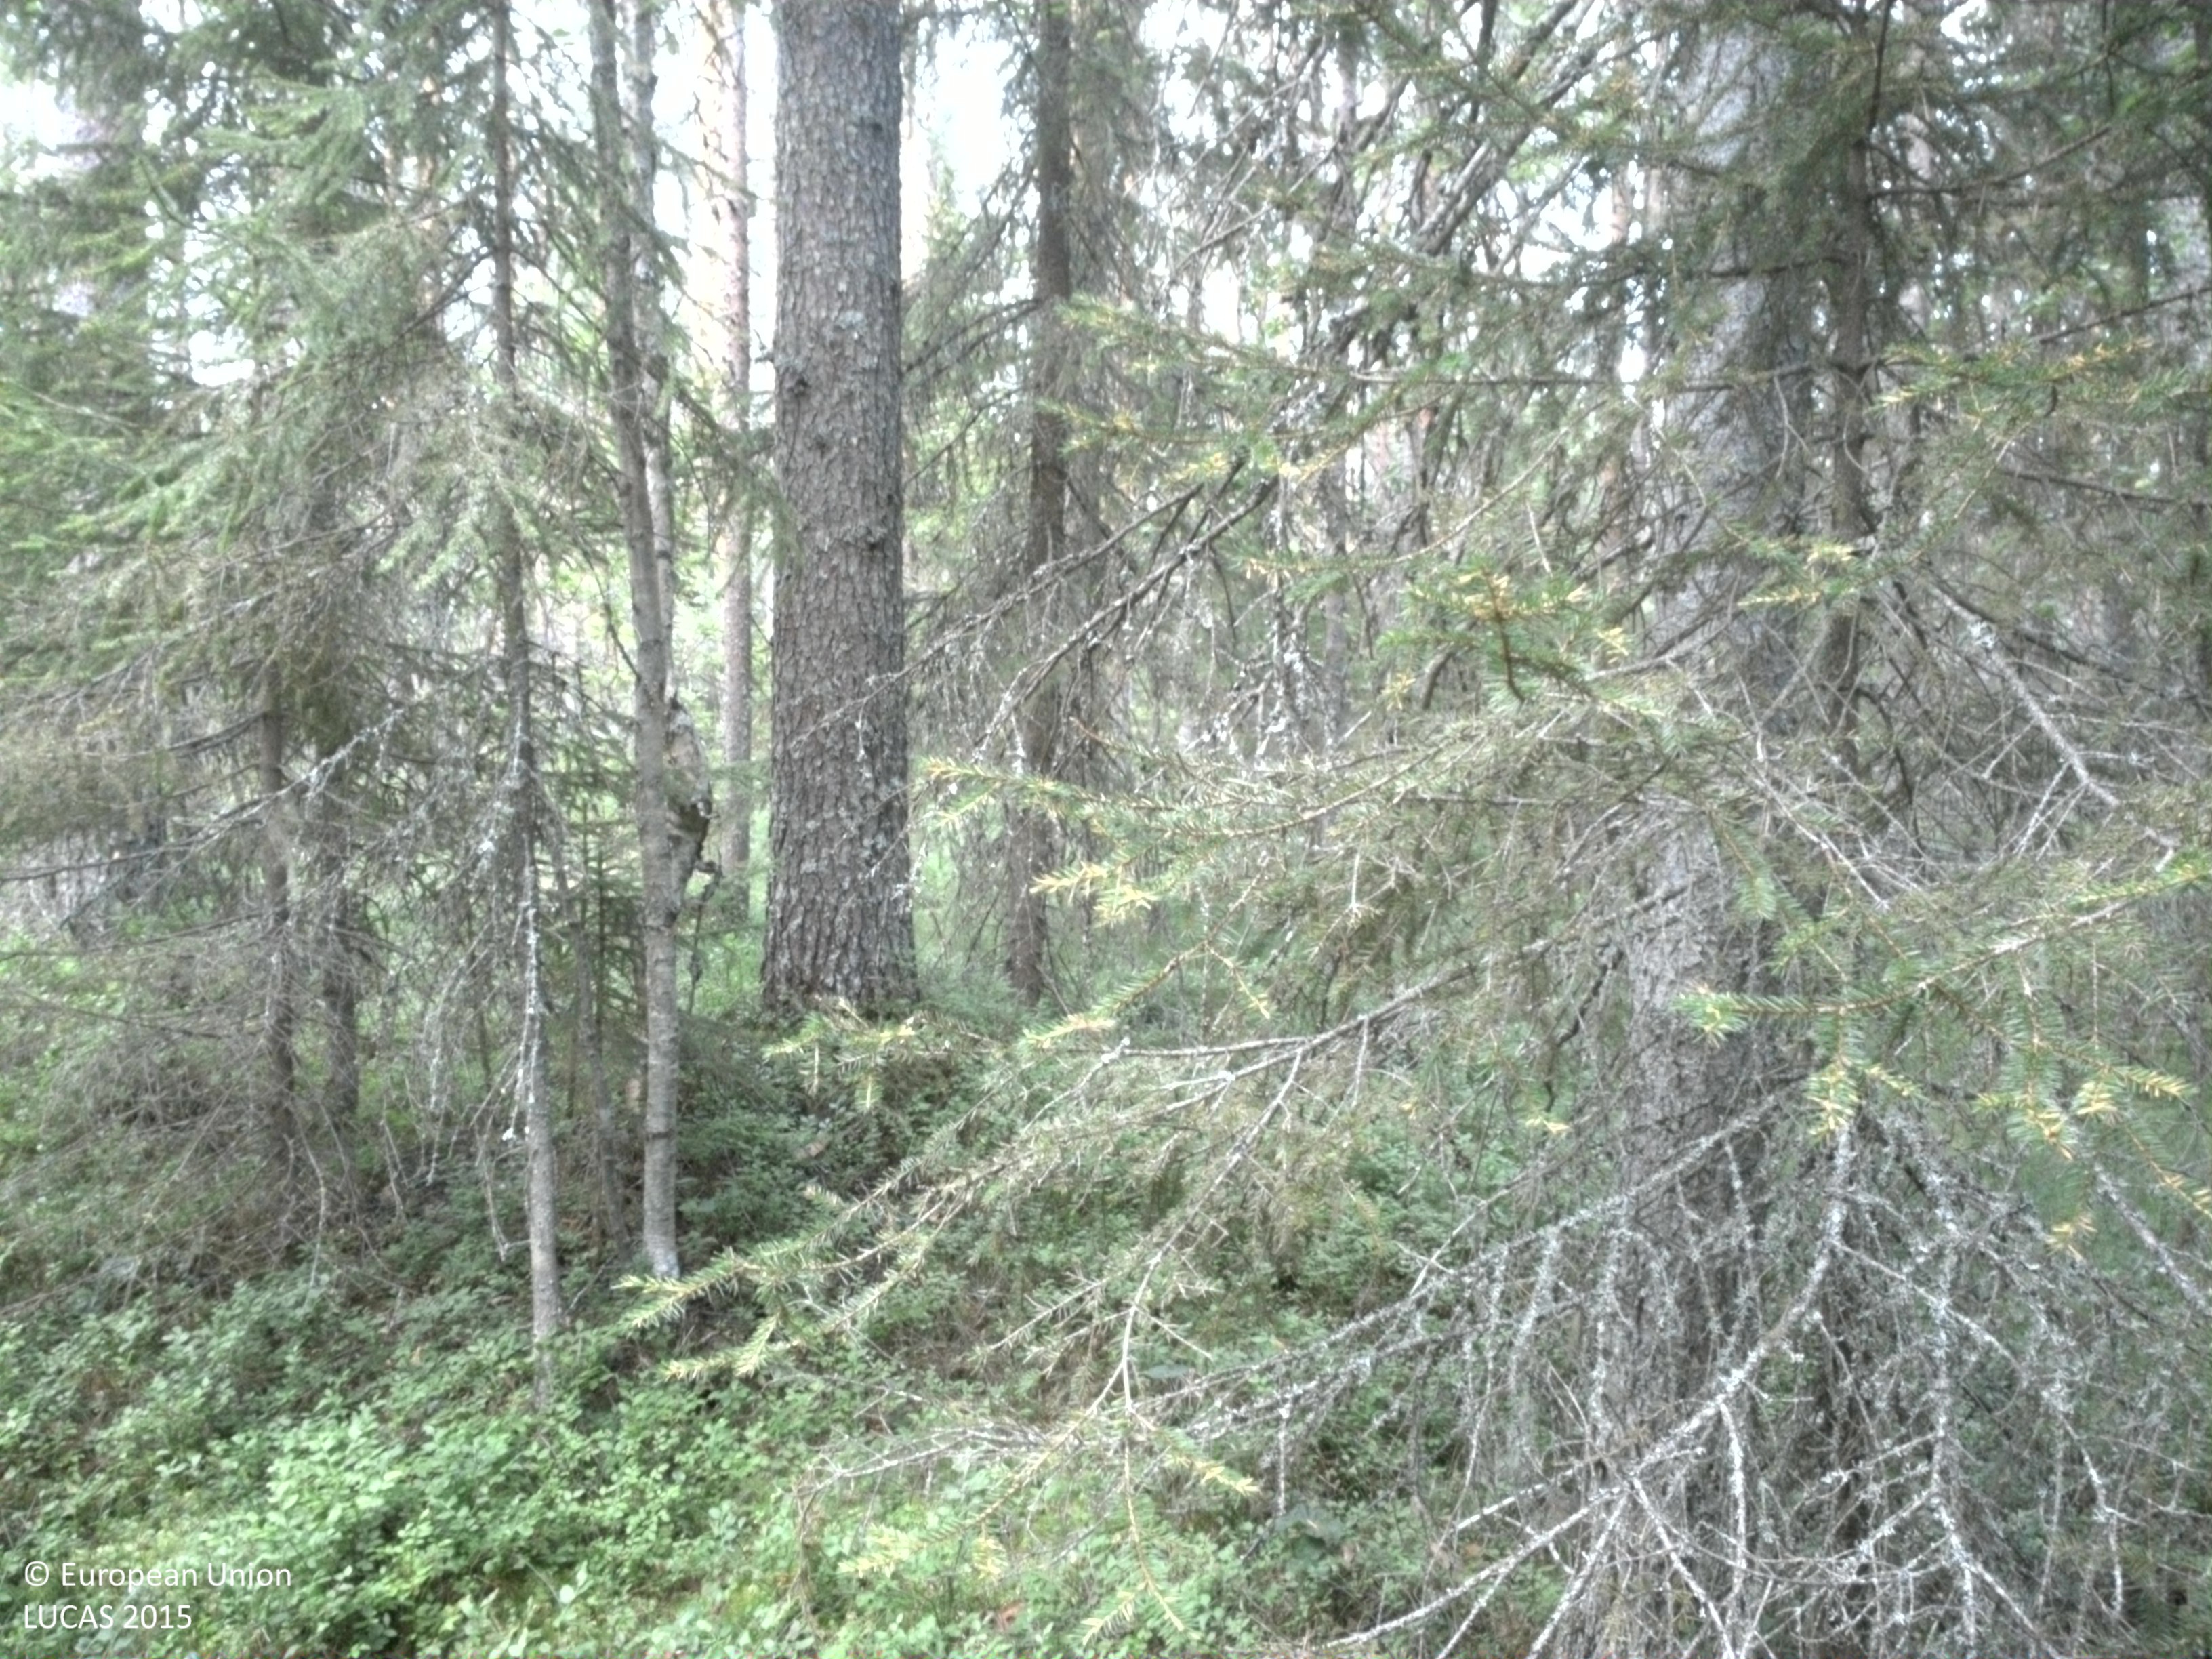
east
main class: Woodland
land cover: Spruce dominated coniferous woodland
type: boreal forest
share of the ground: 50 - 75 %
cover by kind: coniferous forest trees 70 %, shrubs 25 %, lichens and mosses 5 %
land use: Forestry
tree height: > 5 m
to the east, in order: Spruce dominated coniferous woodland; Other coniferous woodland; Shrubland without tree cover; Electric lines; Other coniferous woodland; Spruce dominated coniferous woodland; Other mixed woodland; Ditches and canals; Grass margins; Paved roads, cycling and walking lanes; Grass margins
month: August
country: SE
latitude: 64.2458
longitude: 20.5618
